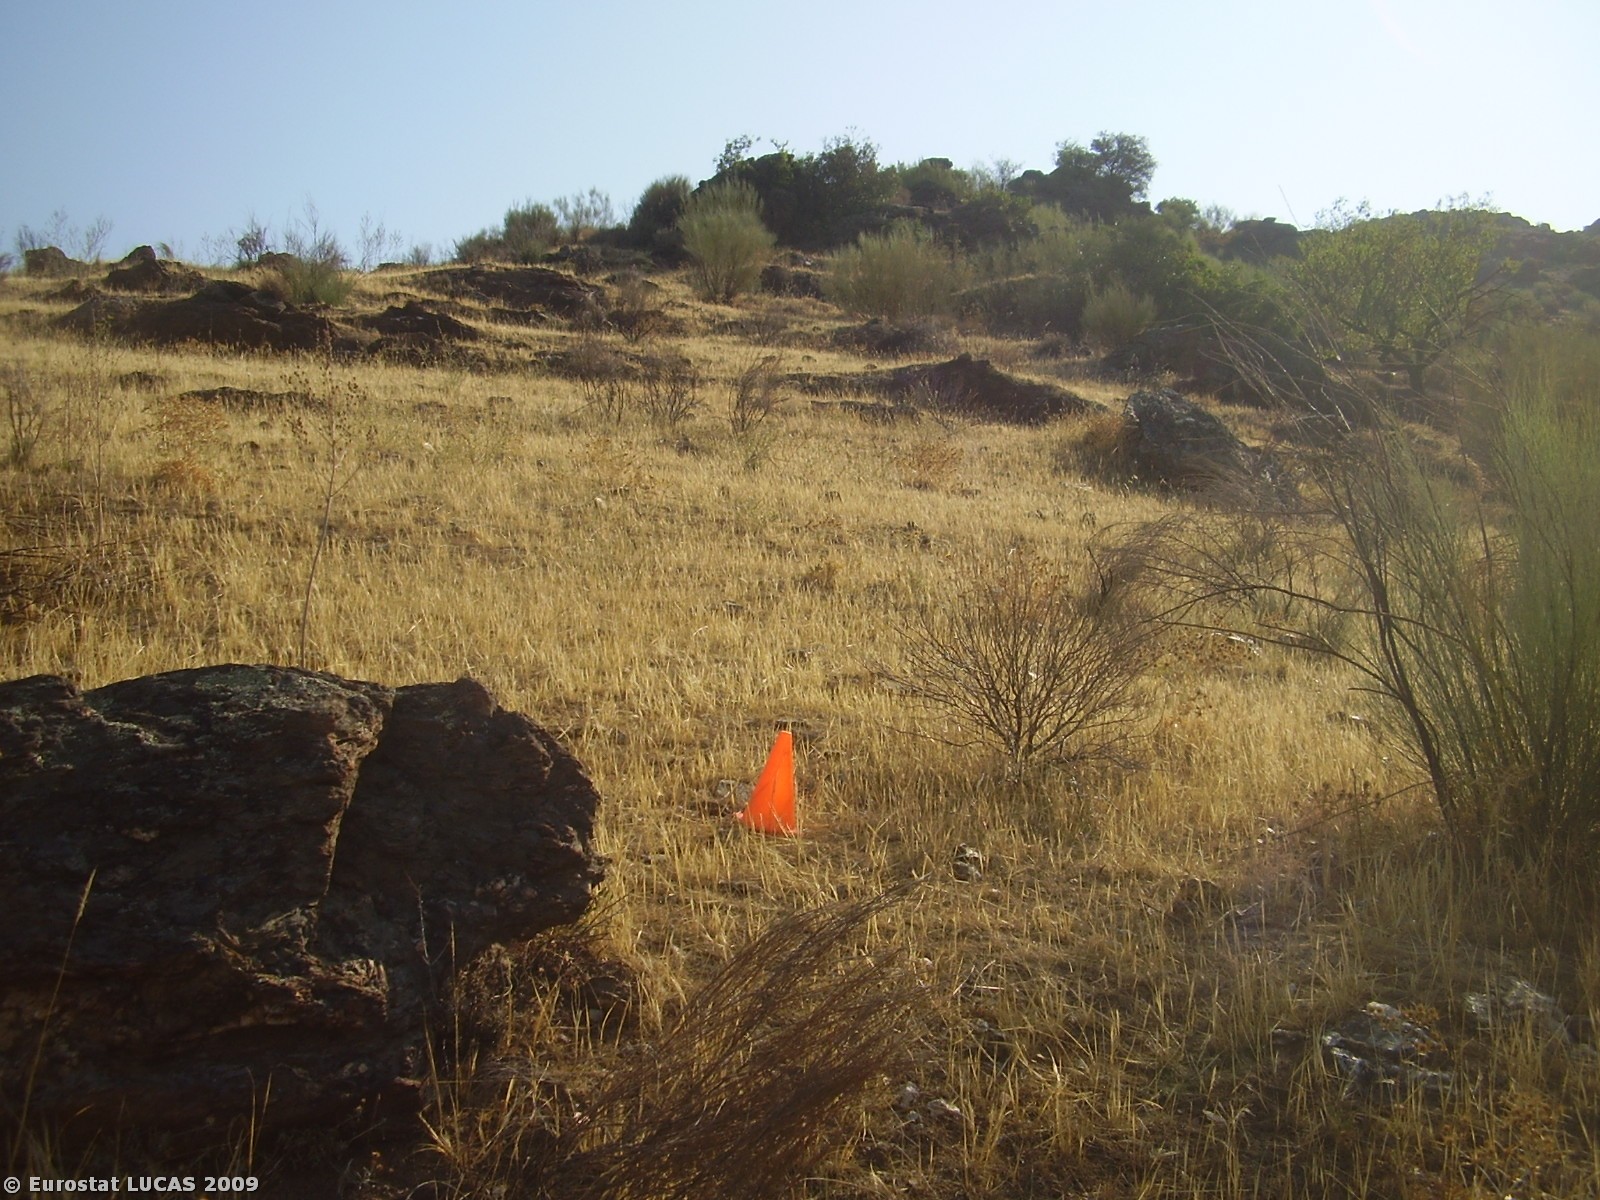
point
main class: Grassland
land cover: Spontaneously vegetated surfaces
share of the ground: > 75 %
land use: Fallow land
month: August
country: PT
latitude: 41.3301
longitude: -7.0193
